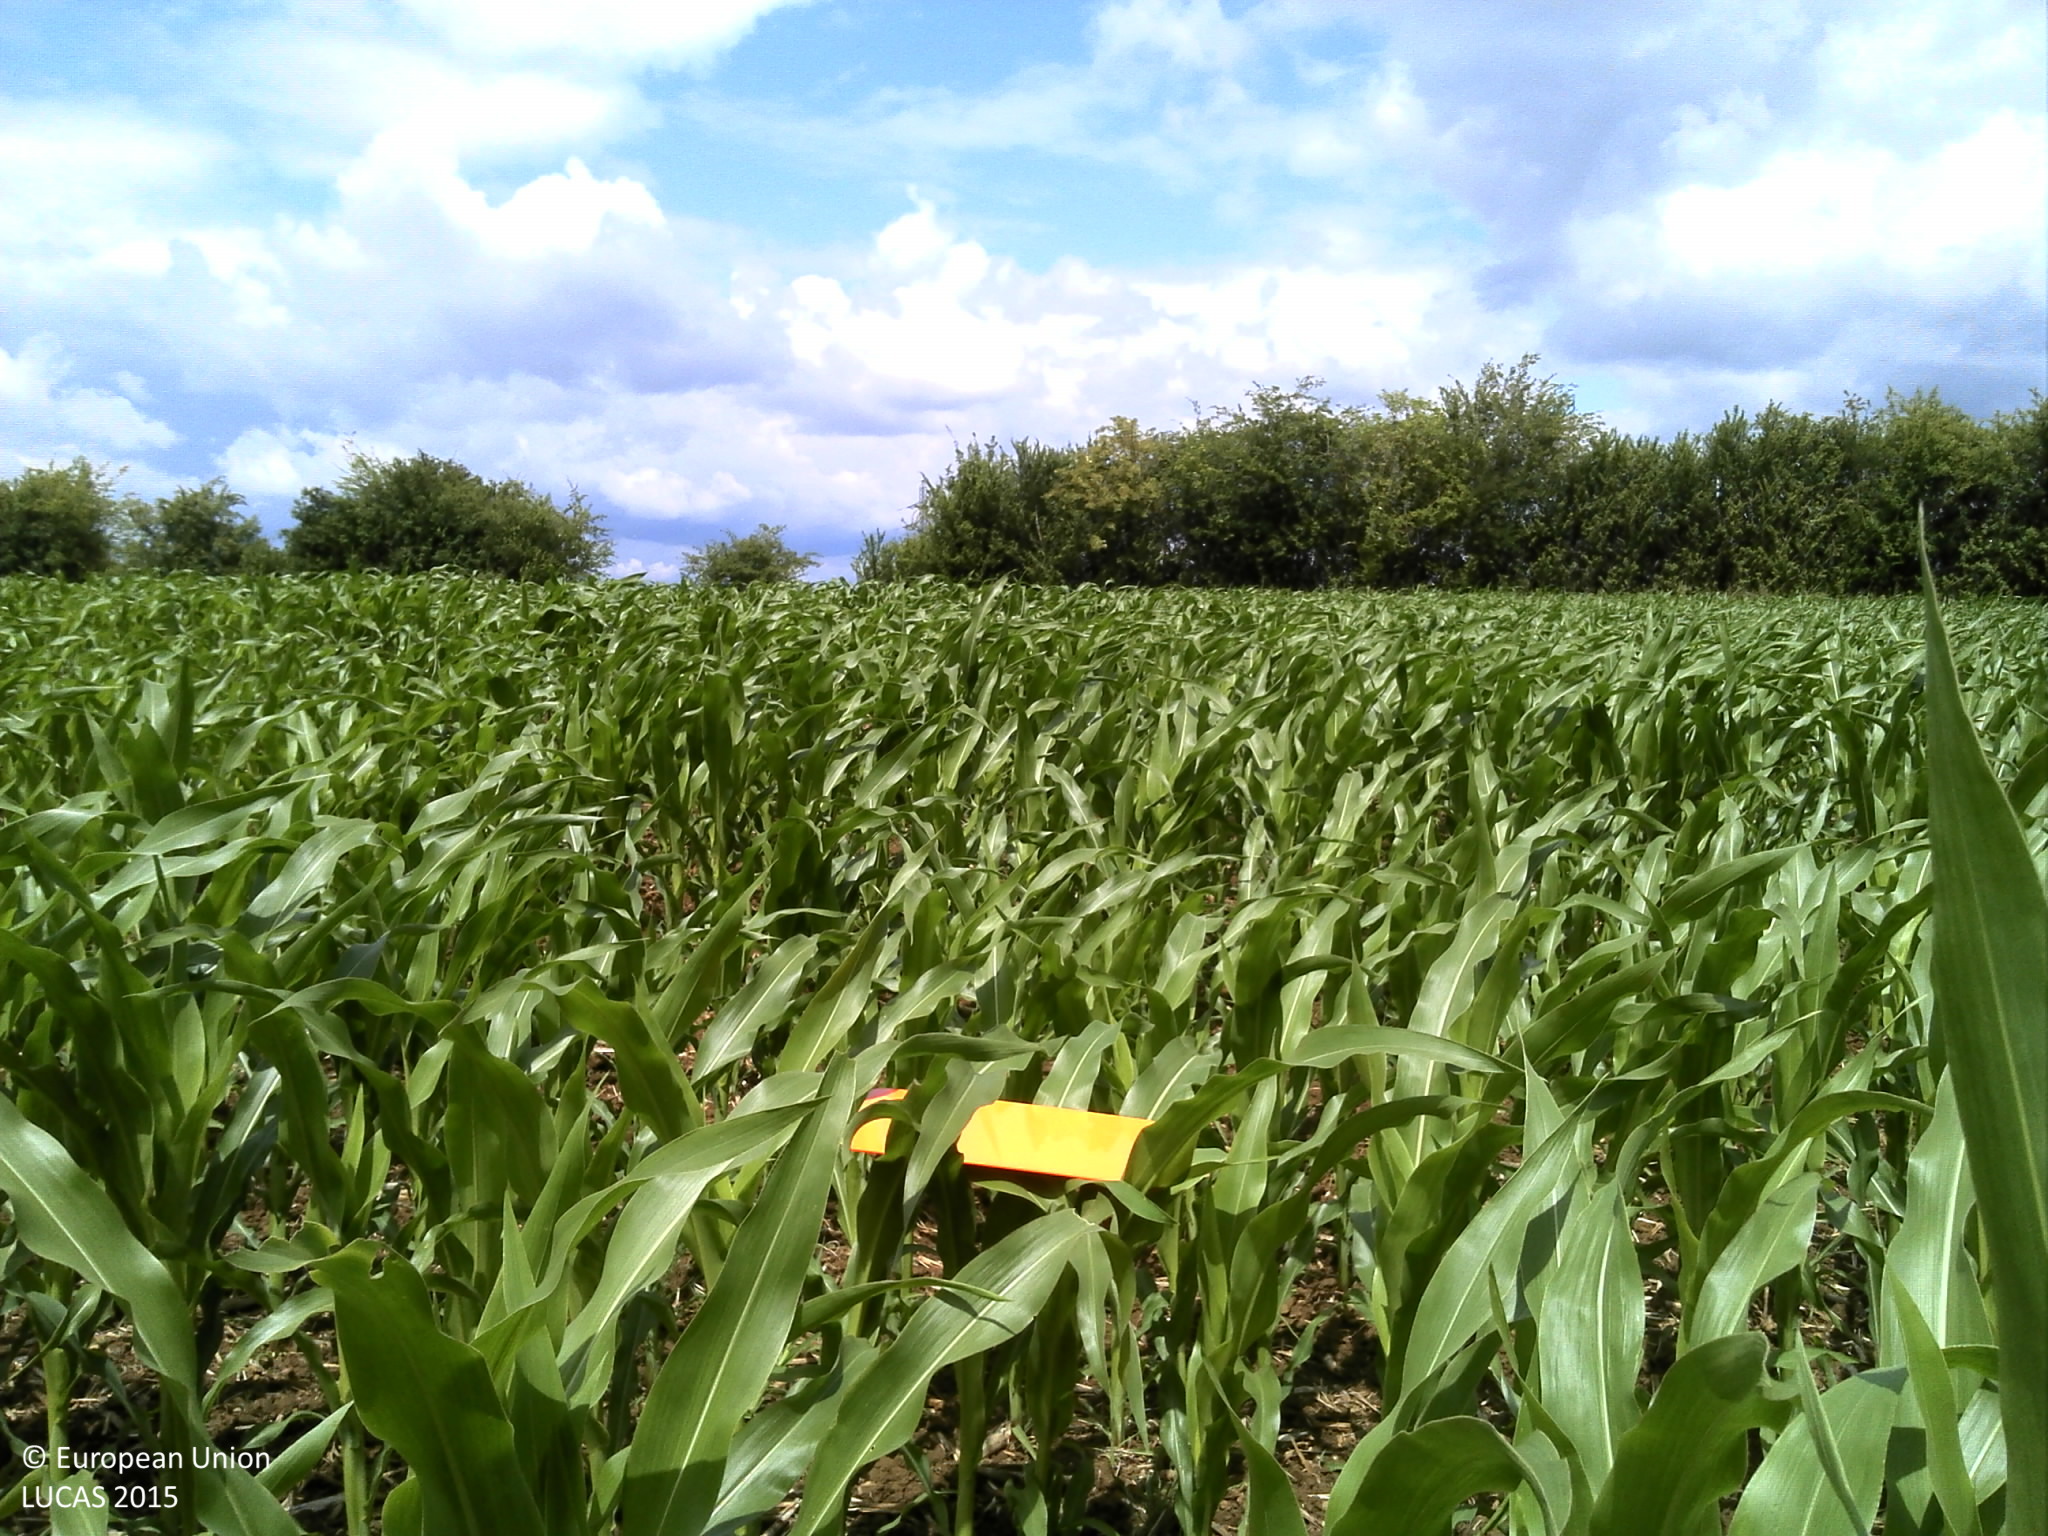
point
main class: Cropland
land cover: Maize
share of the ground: 50 - 75 %
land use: Agriculture (excluding fallow land and kitchen gardens)
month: June
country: FR
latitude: 49.6600
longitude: 4.9964
